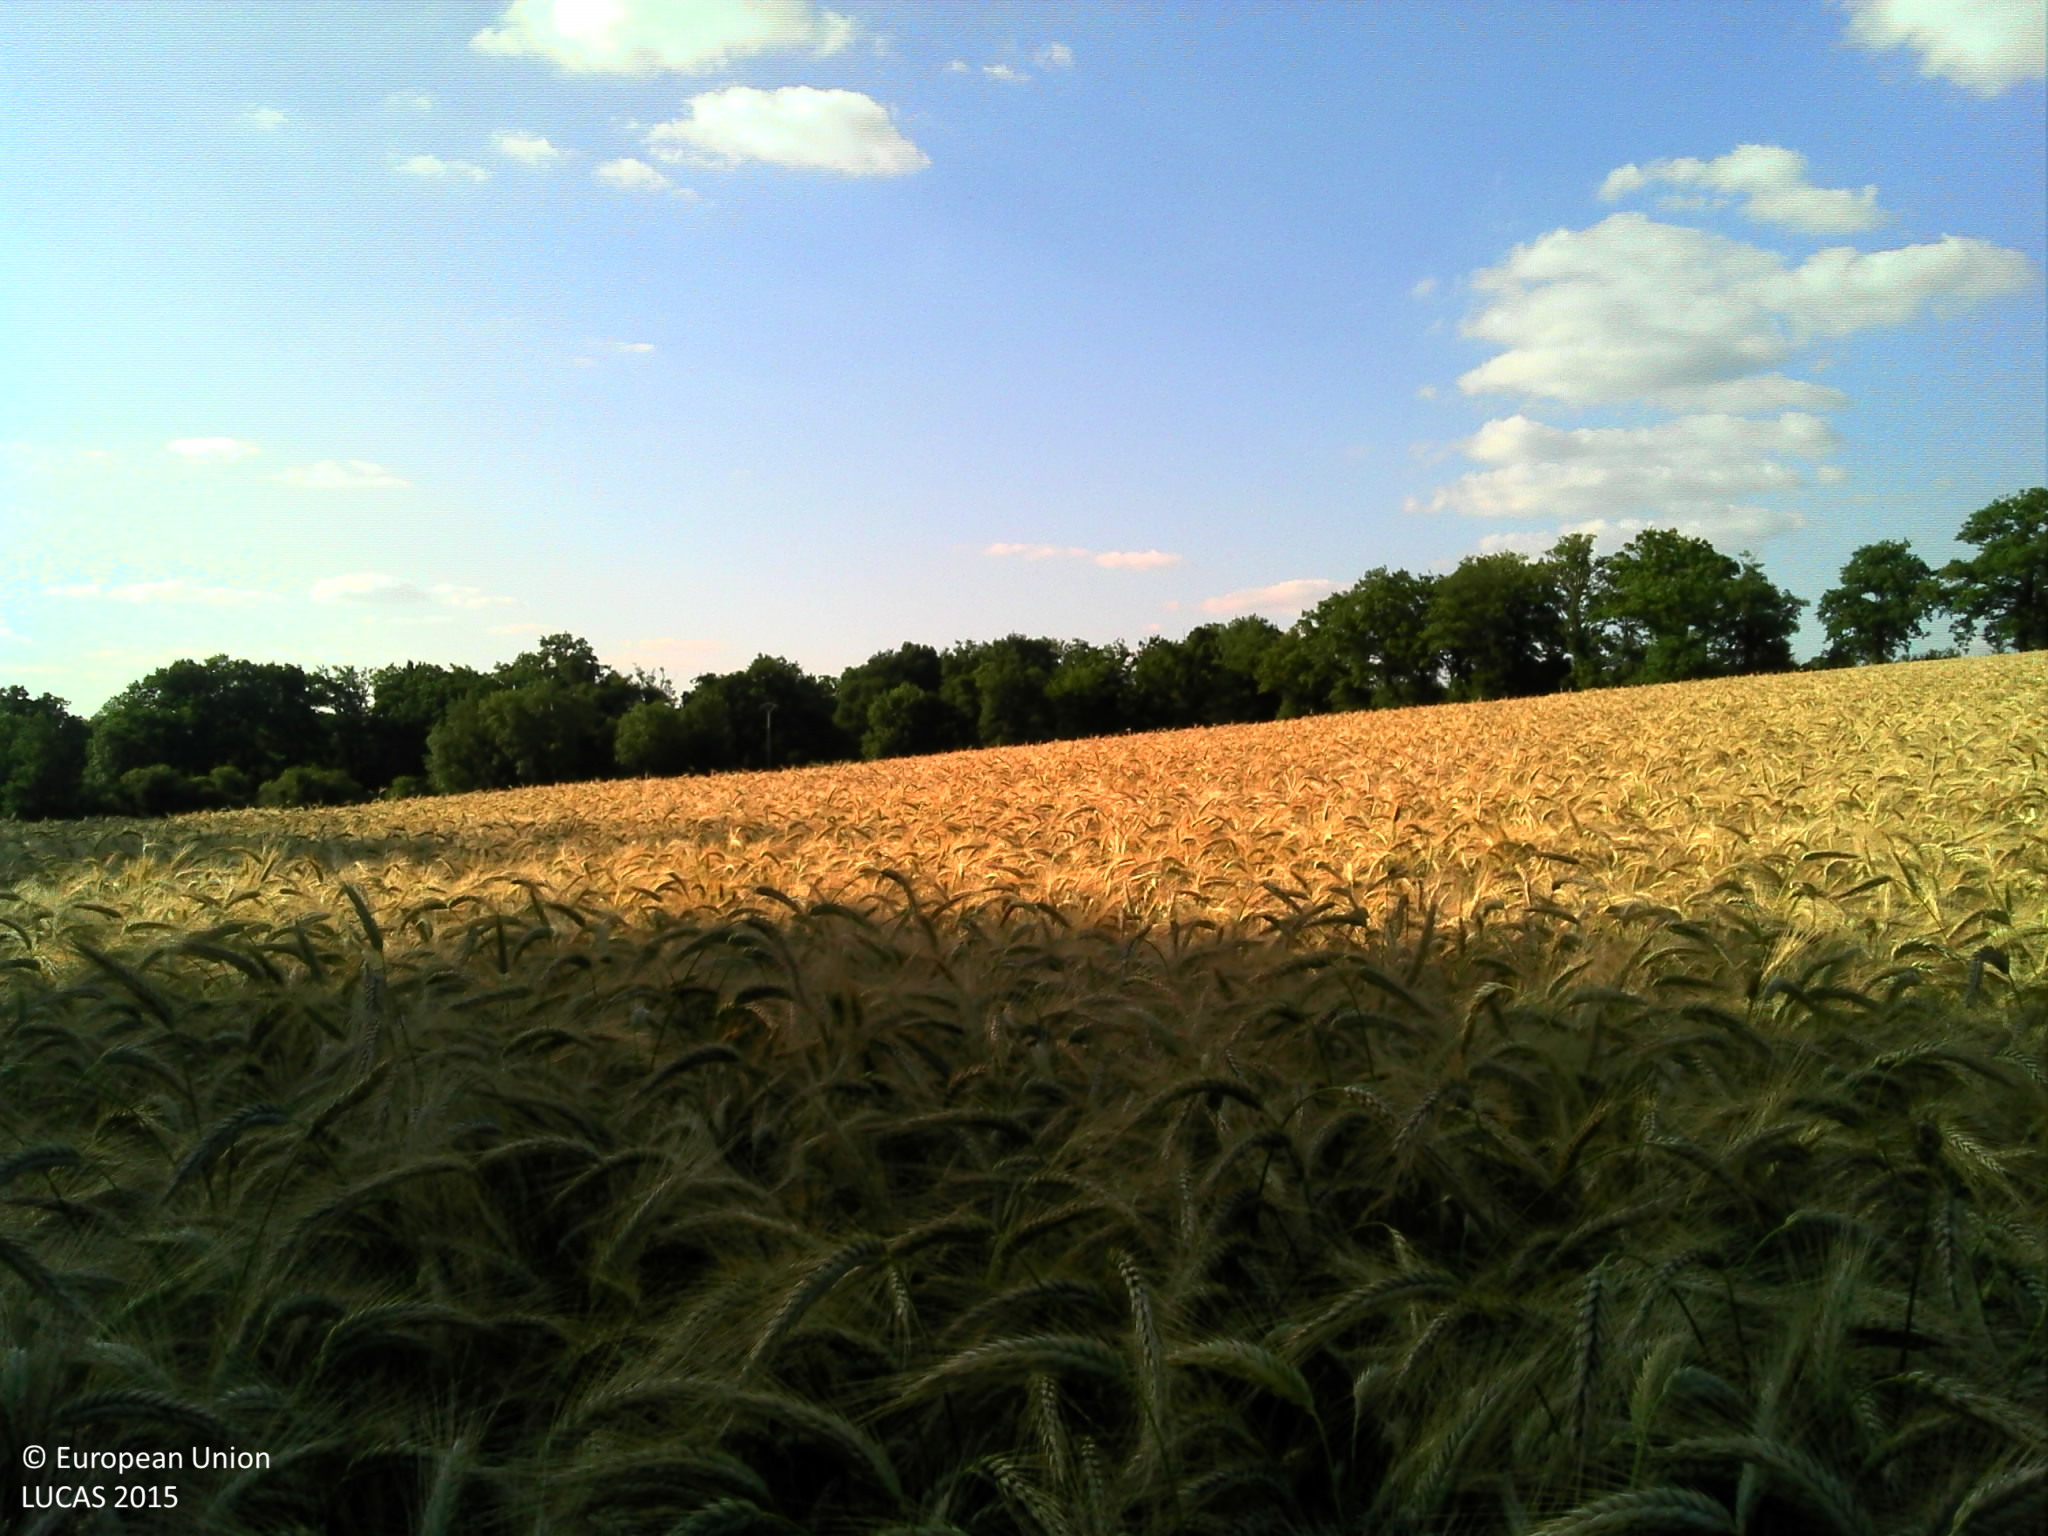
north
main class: Cropland
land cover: Triticale
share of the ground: > 75 %
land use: Agriculture (excluding fallow land and kitchen gardens)
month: June
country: FR
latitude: 45.9418
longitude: 0.6603
